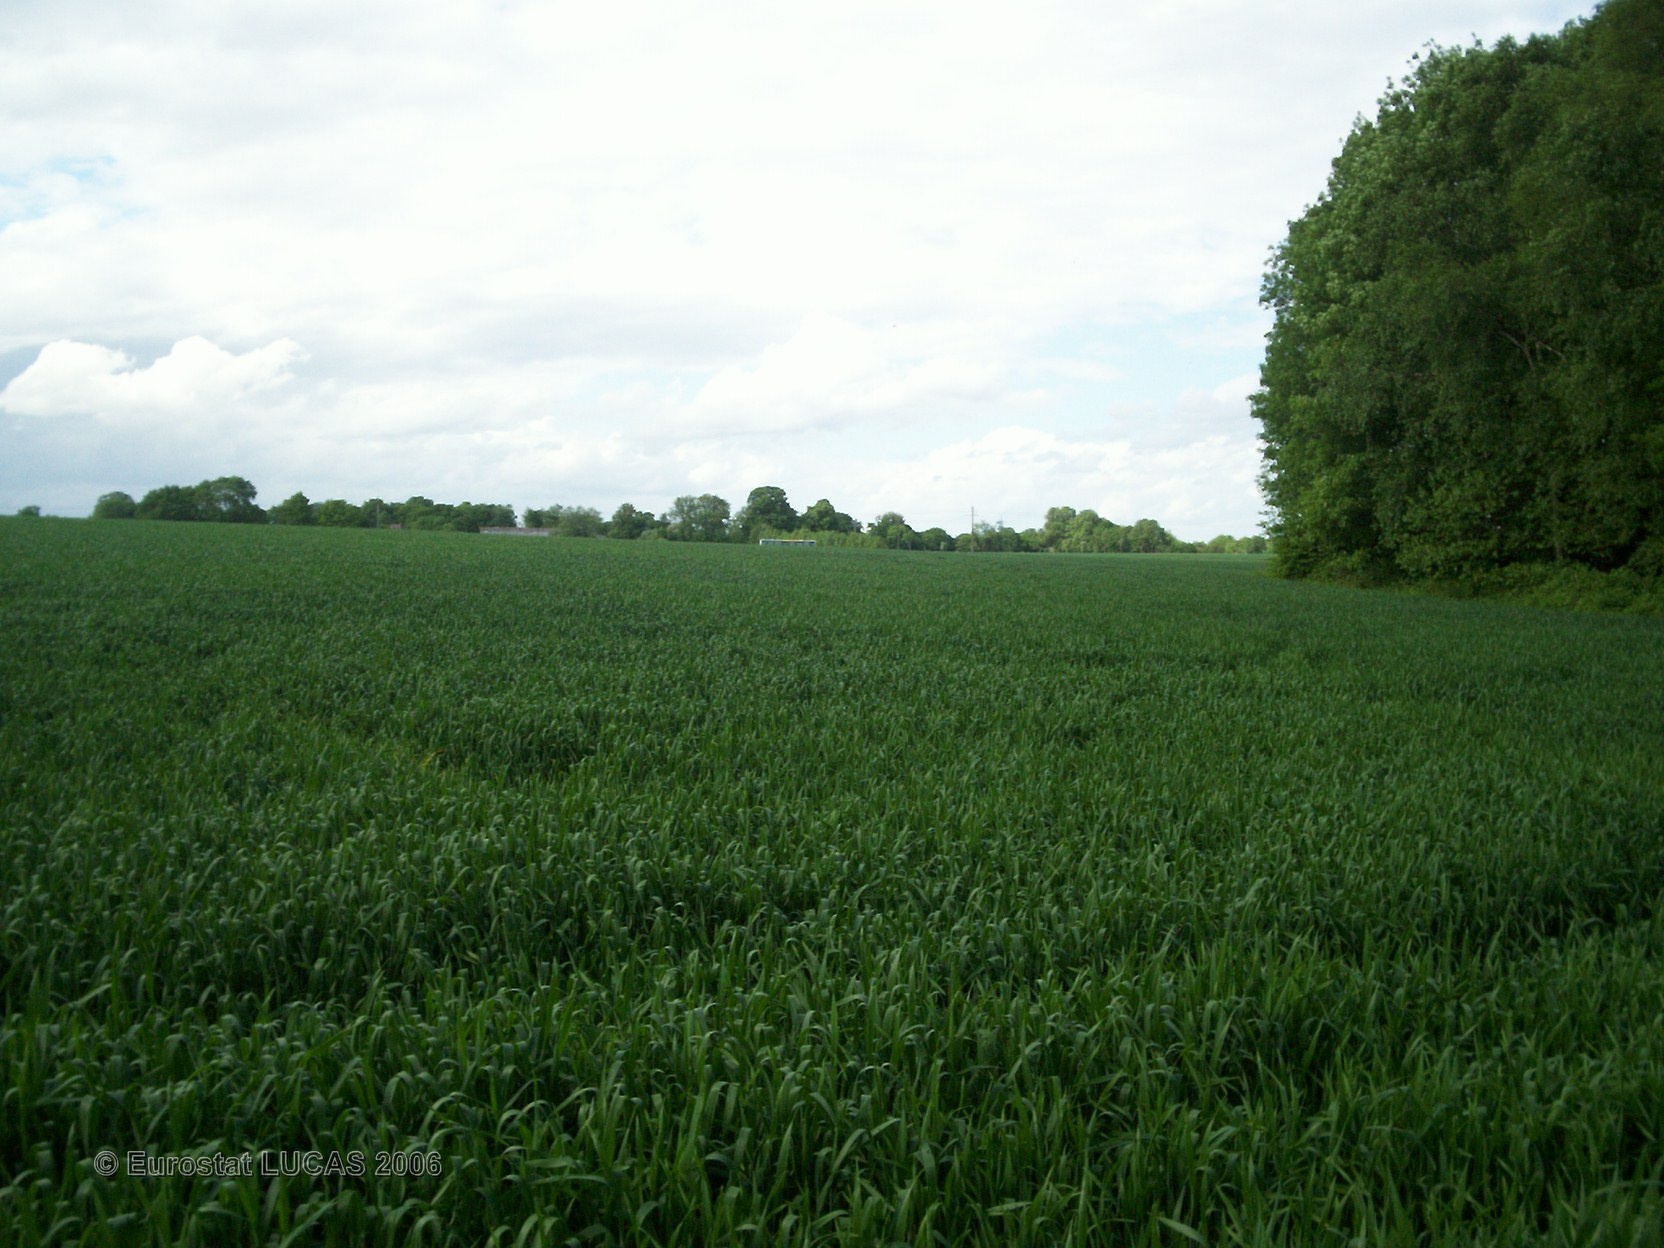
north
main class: Cropland
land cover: Common wheat
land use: Agriculture (excluding fallow land and kitchen gardens)
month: May
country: FR
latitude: 49.3891
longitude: 0.5089
